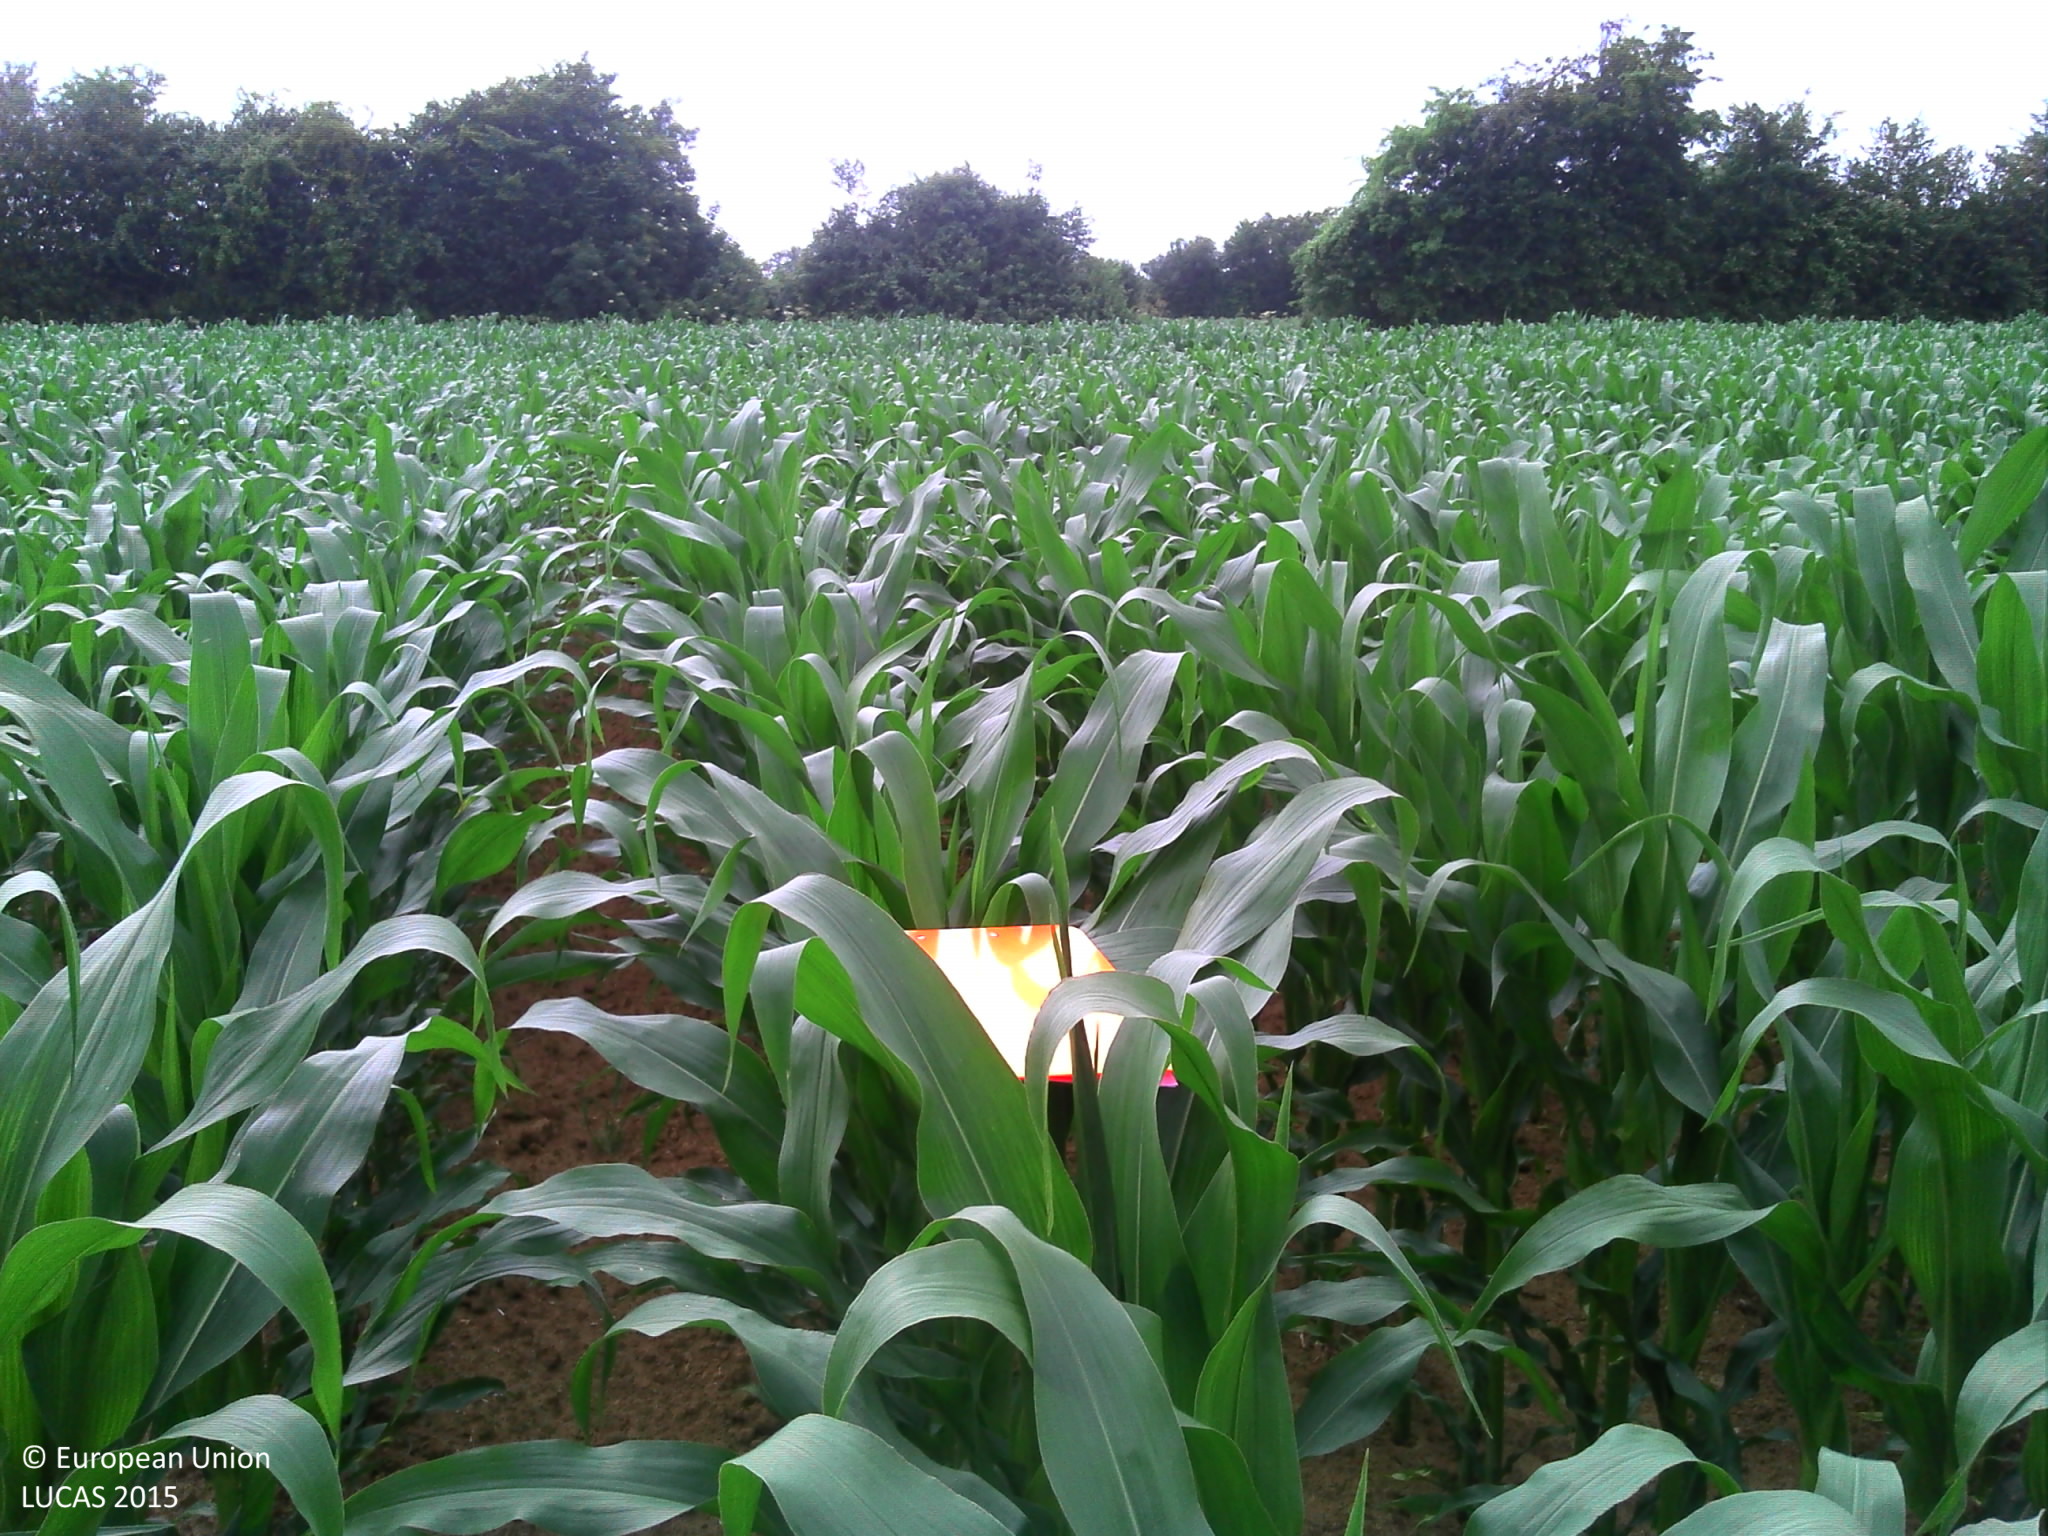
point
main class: Cropland
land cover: Maize
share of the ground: > 75 %
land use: Agriculture (excluding fallow land and kitchen gardens)
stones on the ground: < 10 %
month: July
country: FR
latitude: 48.9653
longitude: 0.0118
